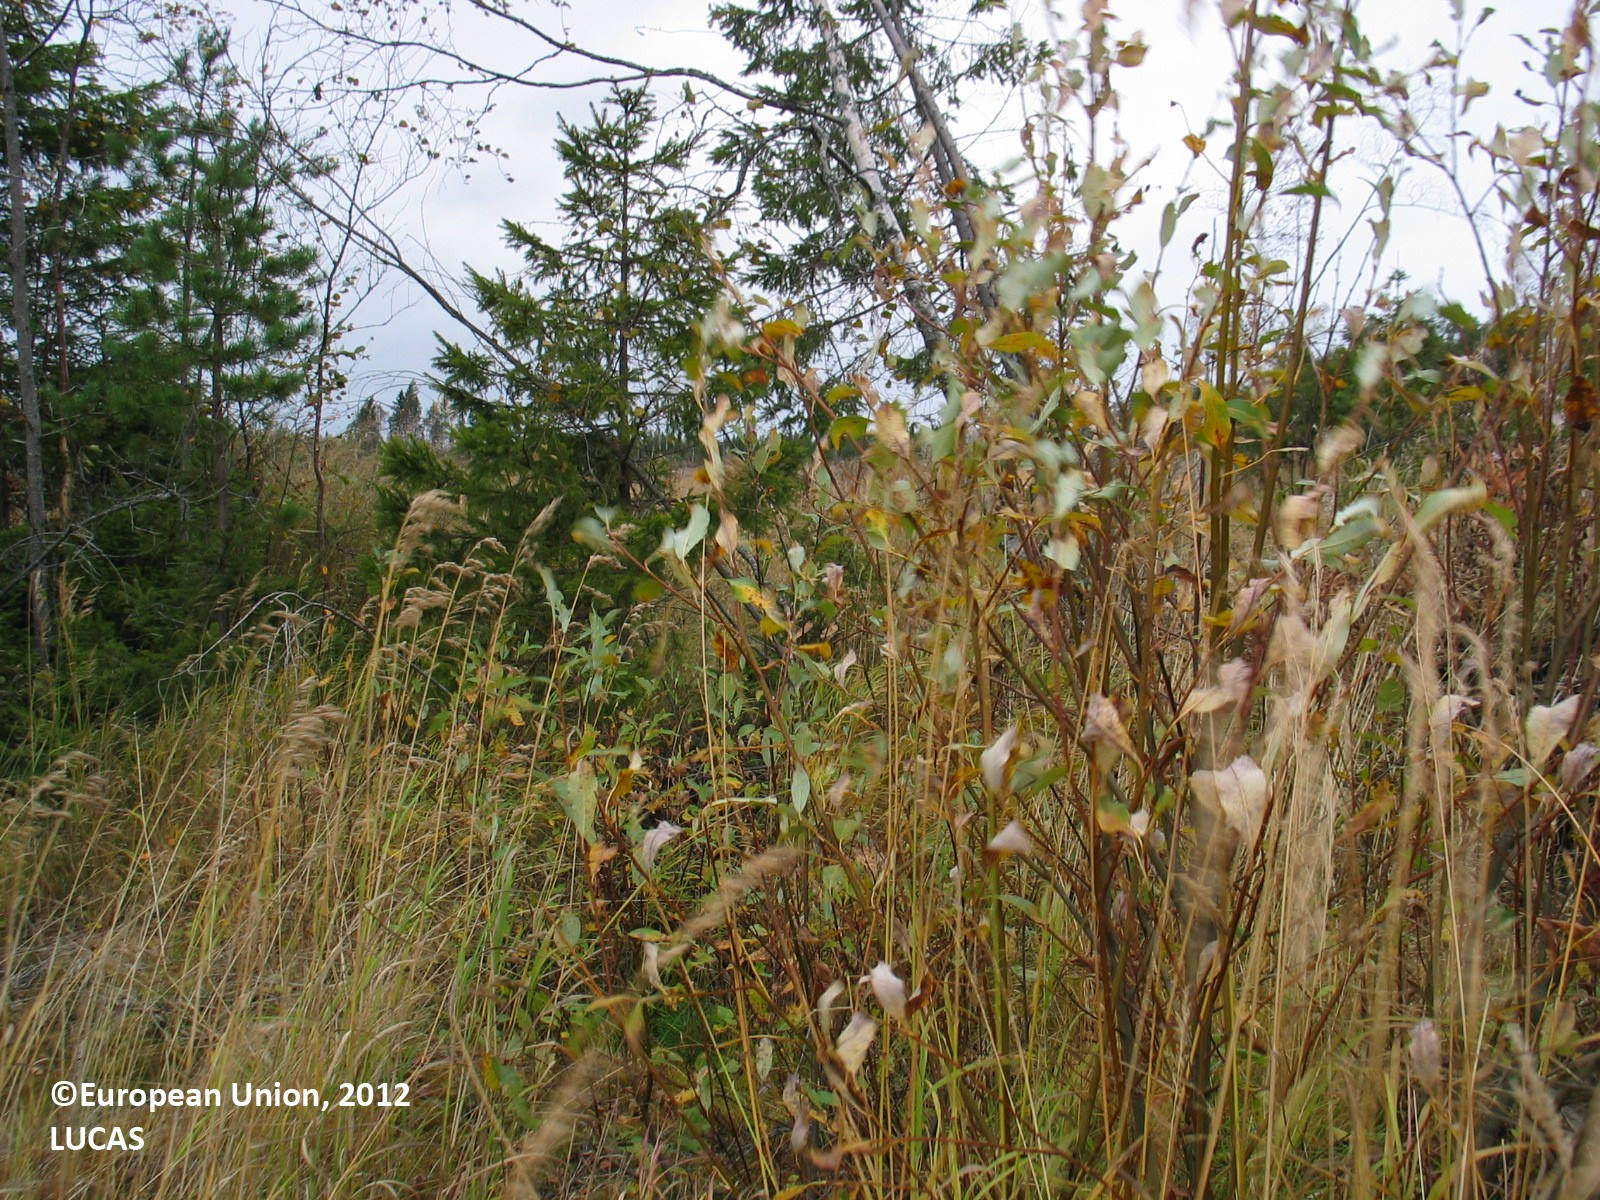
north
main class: Grassland
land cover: Grassland with sparse tree/shrub cover
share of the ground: > 75 %
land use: Forestry
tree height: < 5 m
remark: Clear cut
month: September
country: FI
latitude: 65.3218
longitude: 25.6013
